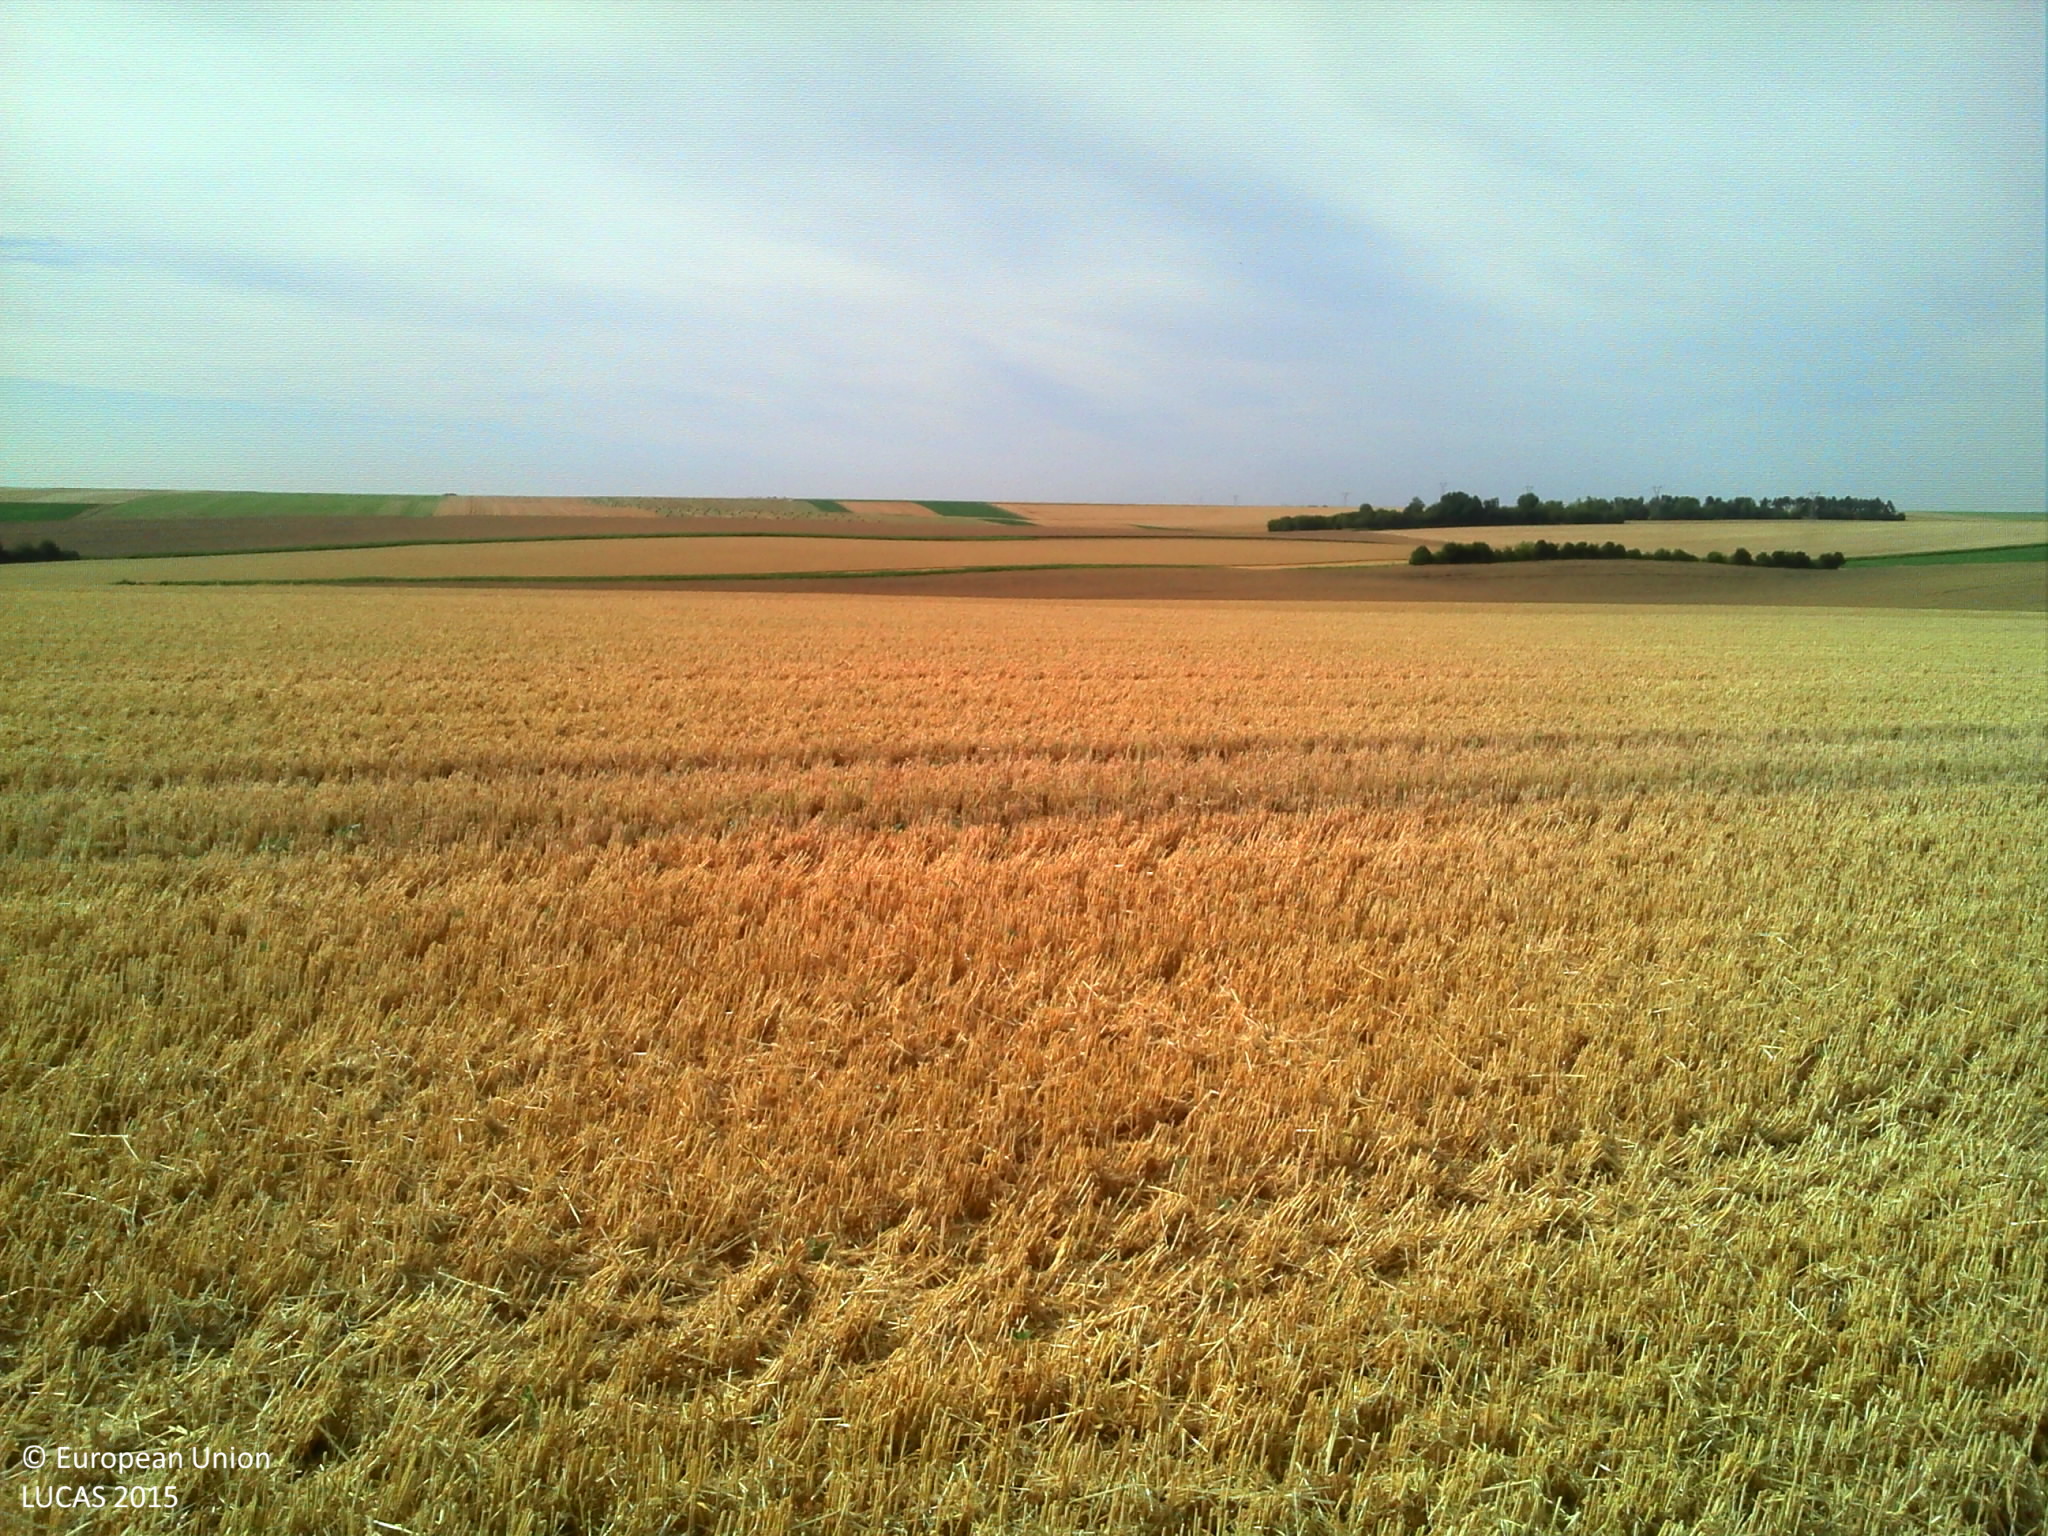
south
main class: Cropland
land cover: Barley
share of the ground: > 75 %
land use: Agriculture (excluding fallow land and kitchen gardens)
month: July
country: FR
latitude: 49.2232
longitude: 4.5181
